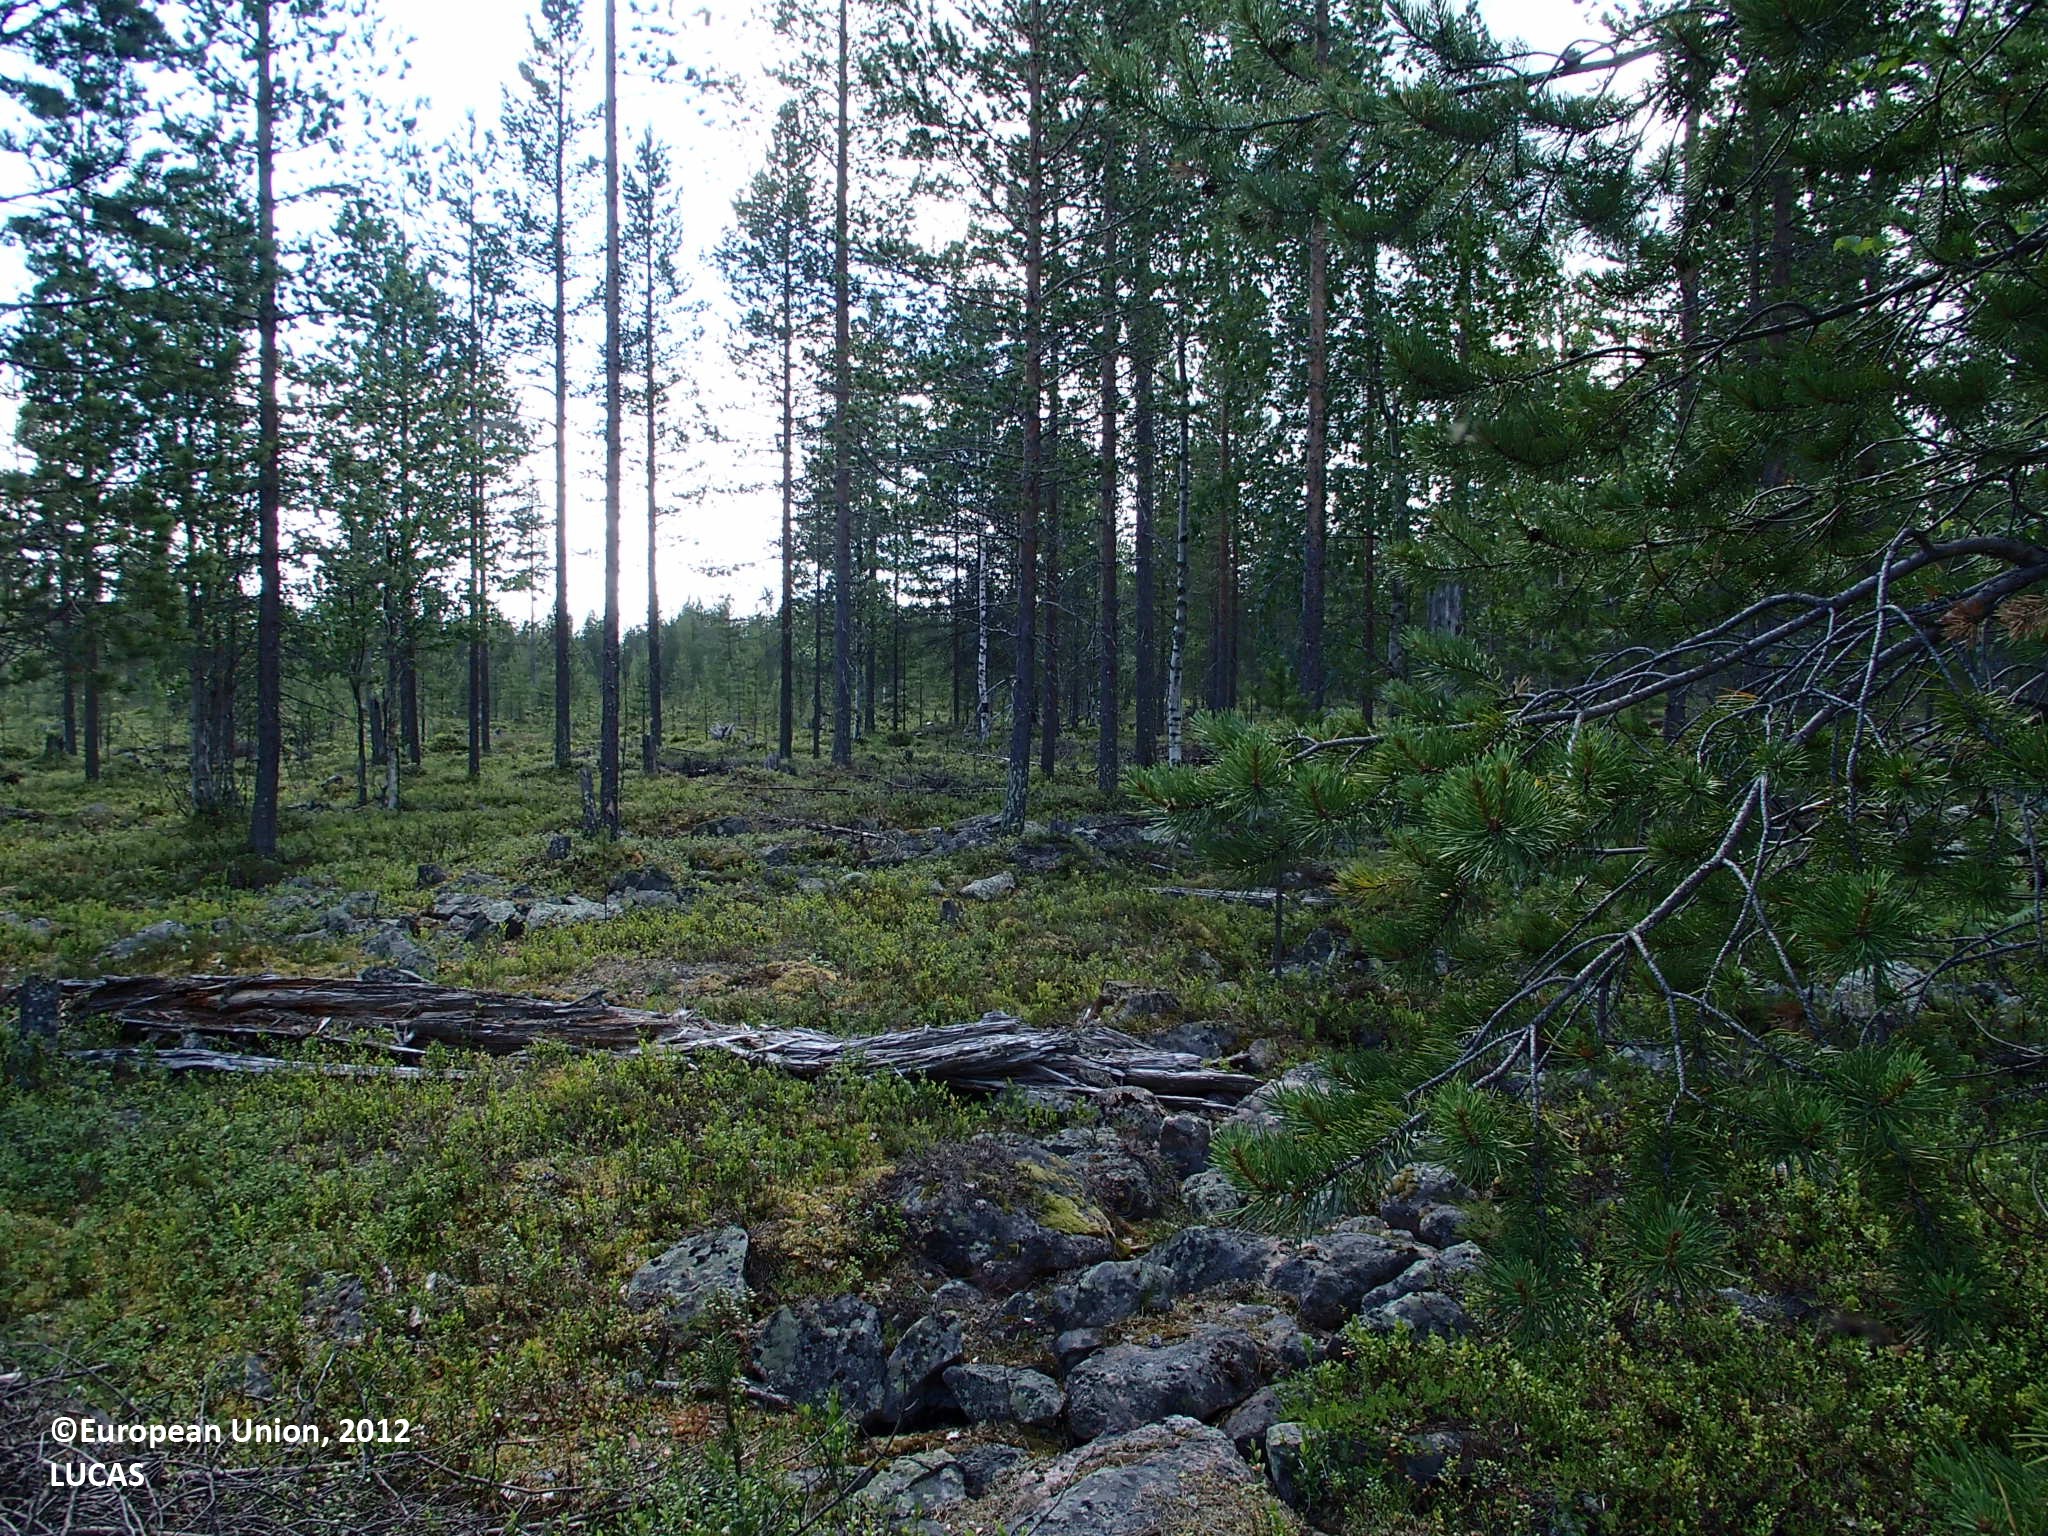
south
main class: Woodland
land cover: Pine dominated mixed woodland
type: boreal forest
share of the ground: 25 - 50 %
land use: Forestry
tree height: > 5 m
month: July
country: FI
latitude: 67.1804
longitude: 25.5592
